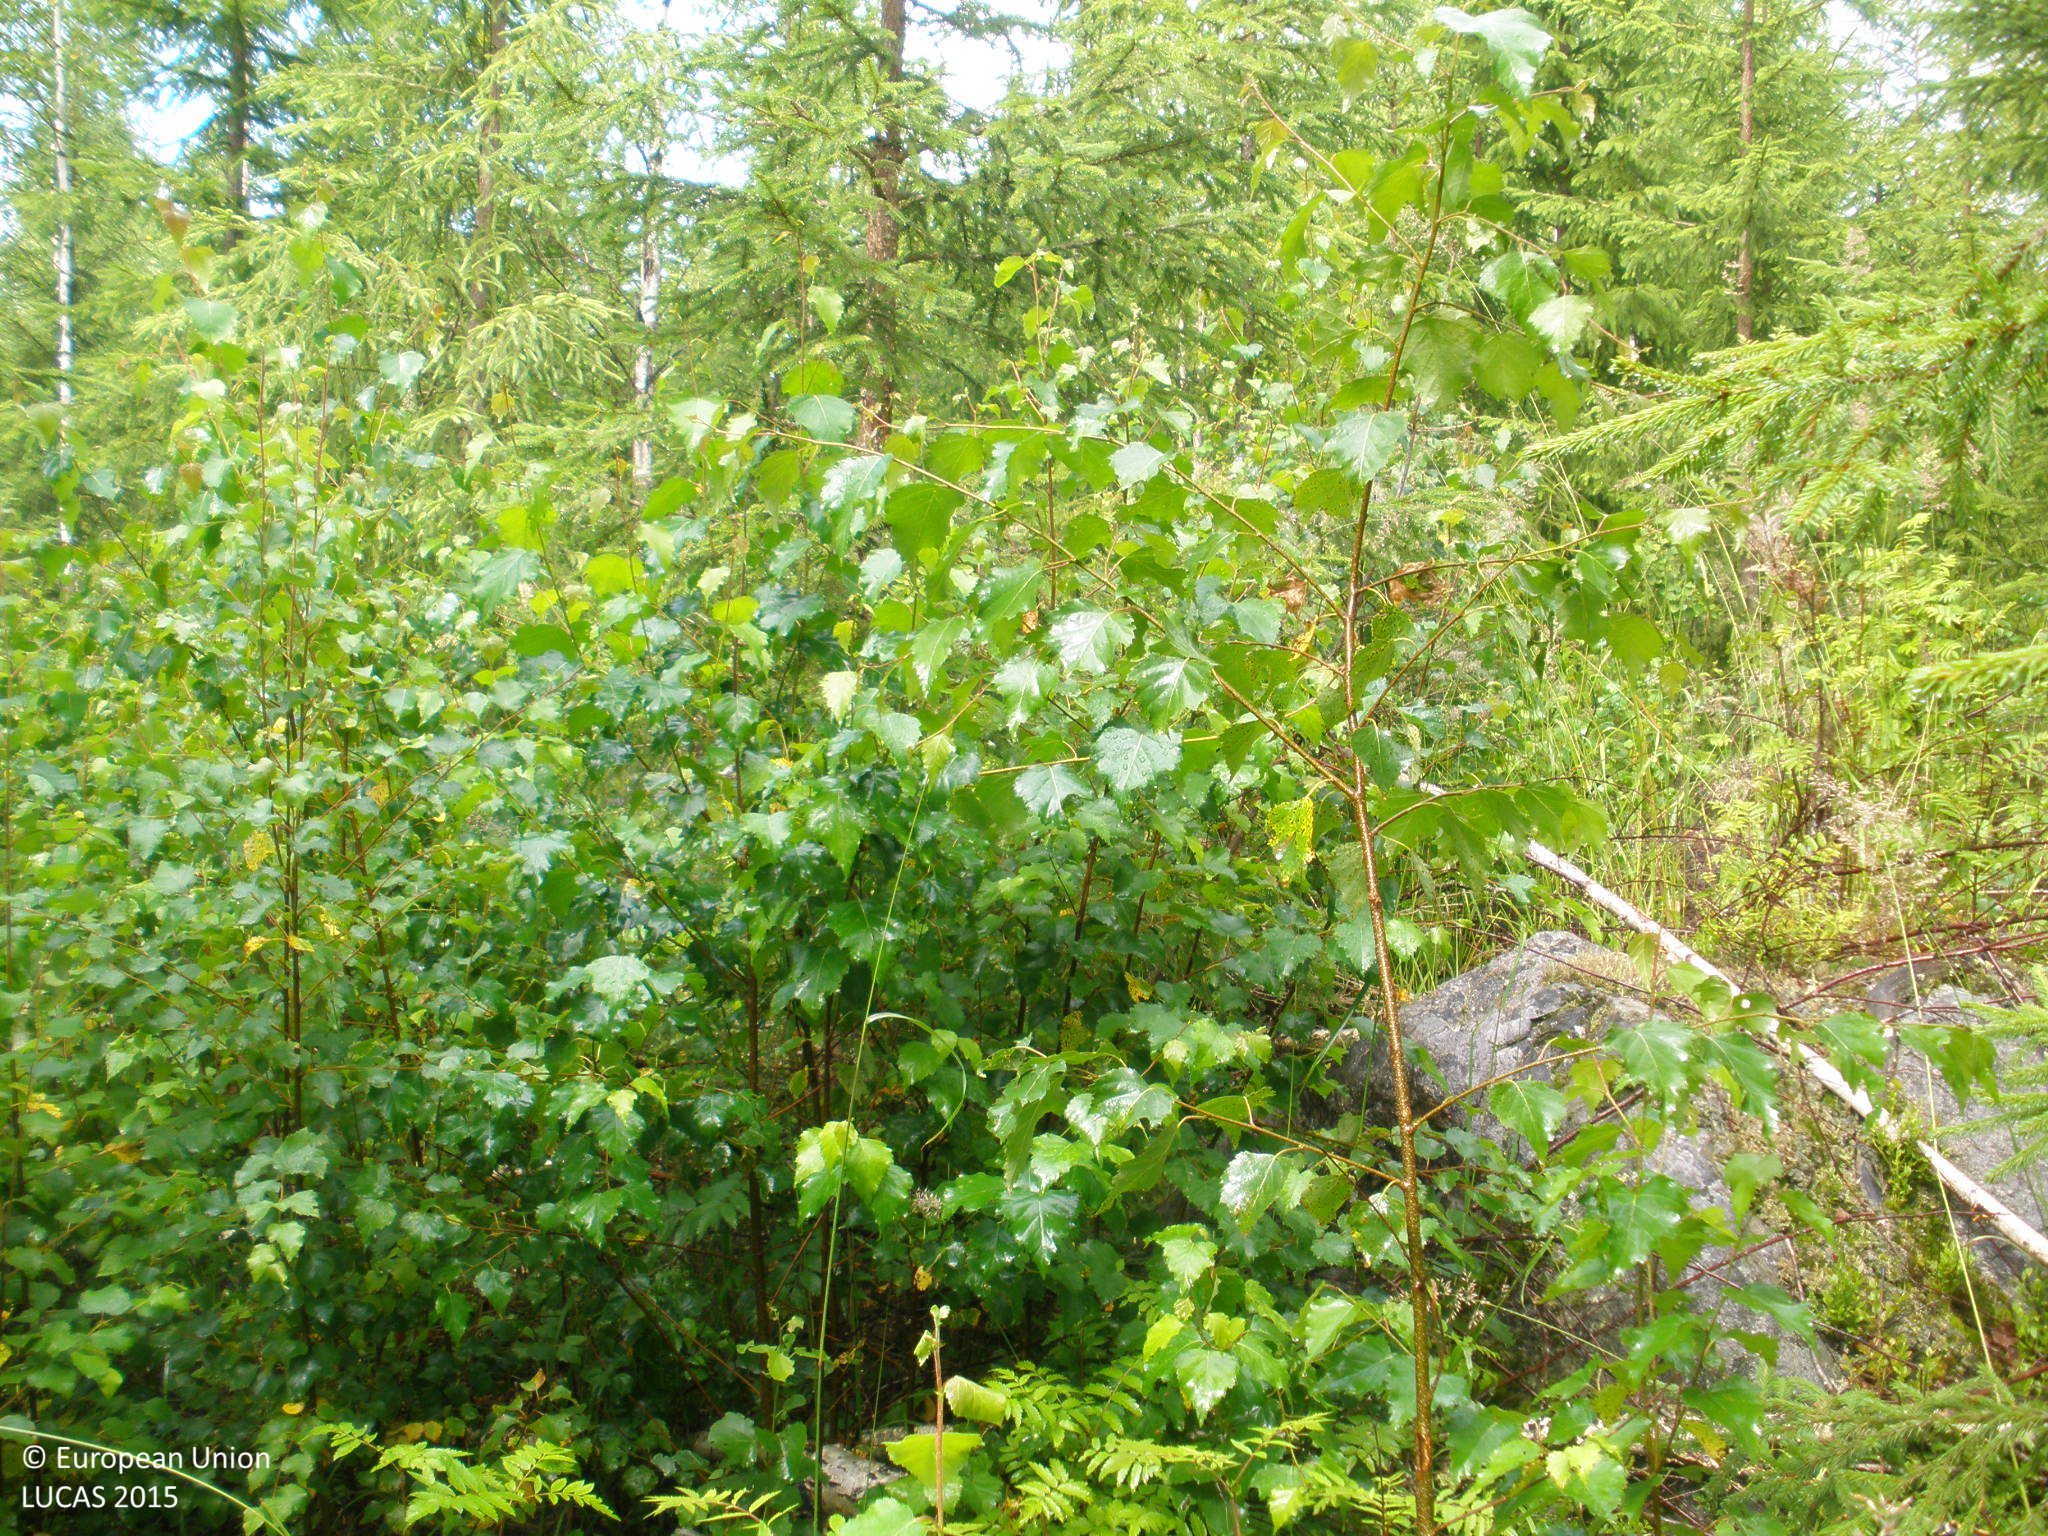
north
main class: Woodland
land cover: Spruce dominated mixed woodland
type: boreal forest
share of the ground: > 75 %
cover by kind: coniferous forest trees 50 %, broadleaved forest trees 25 %, herbaceous plants 15 %, shrubs 10 %
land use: Forestry
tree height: > 5 m
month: July
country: FI
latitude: 61.2295
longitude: 24.9931
